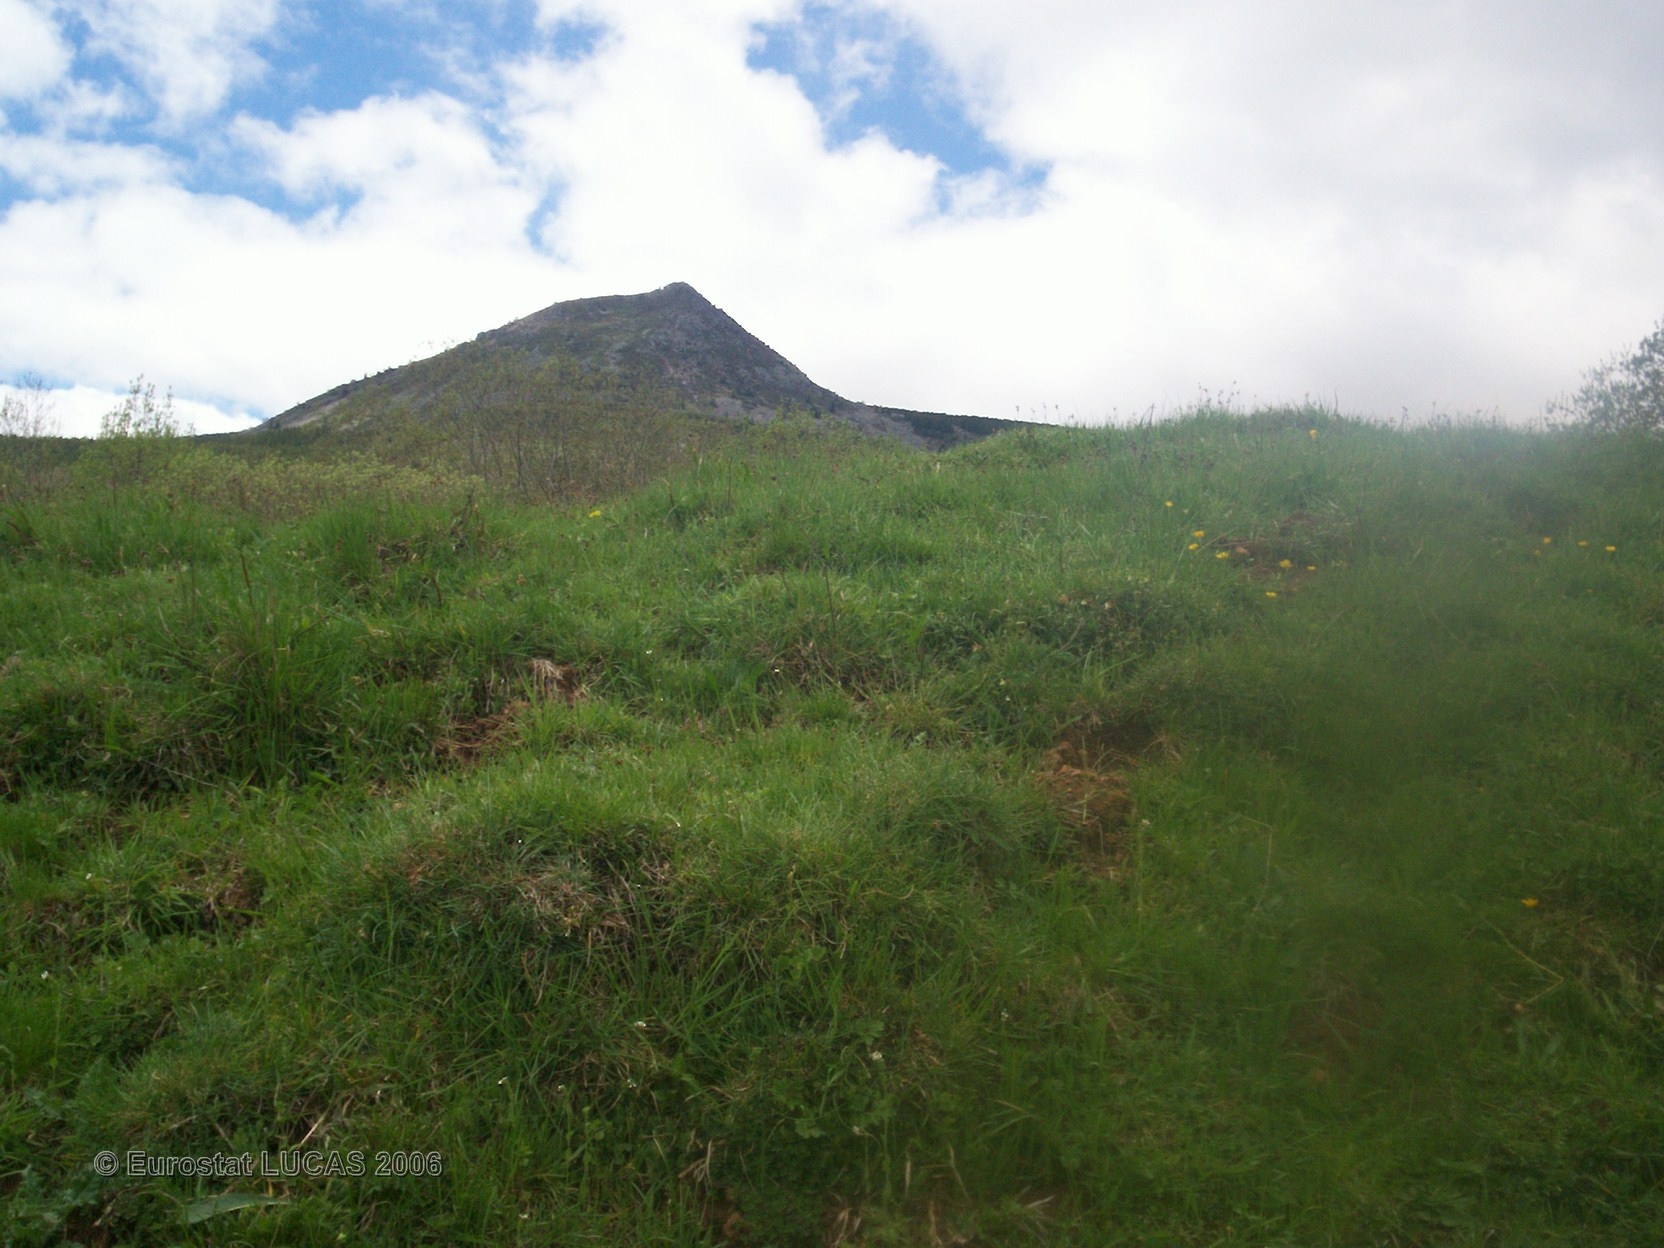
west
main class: Grassland
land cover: Grassland without tree/shrub cover
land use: Agriculture (excluding fallow land and kitchen gardens)
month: May
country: FR
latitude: 44.9122
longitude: 4.2165
